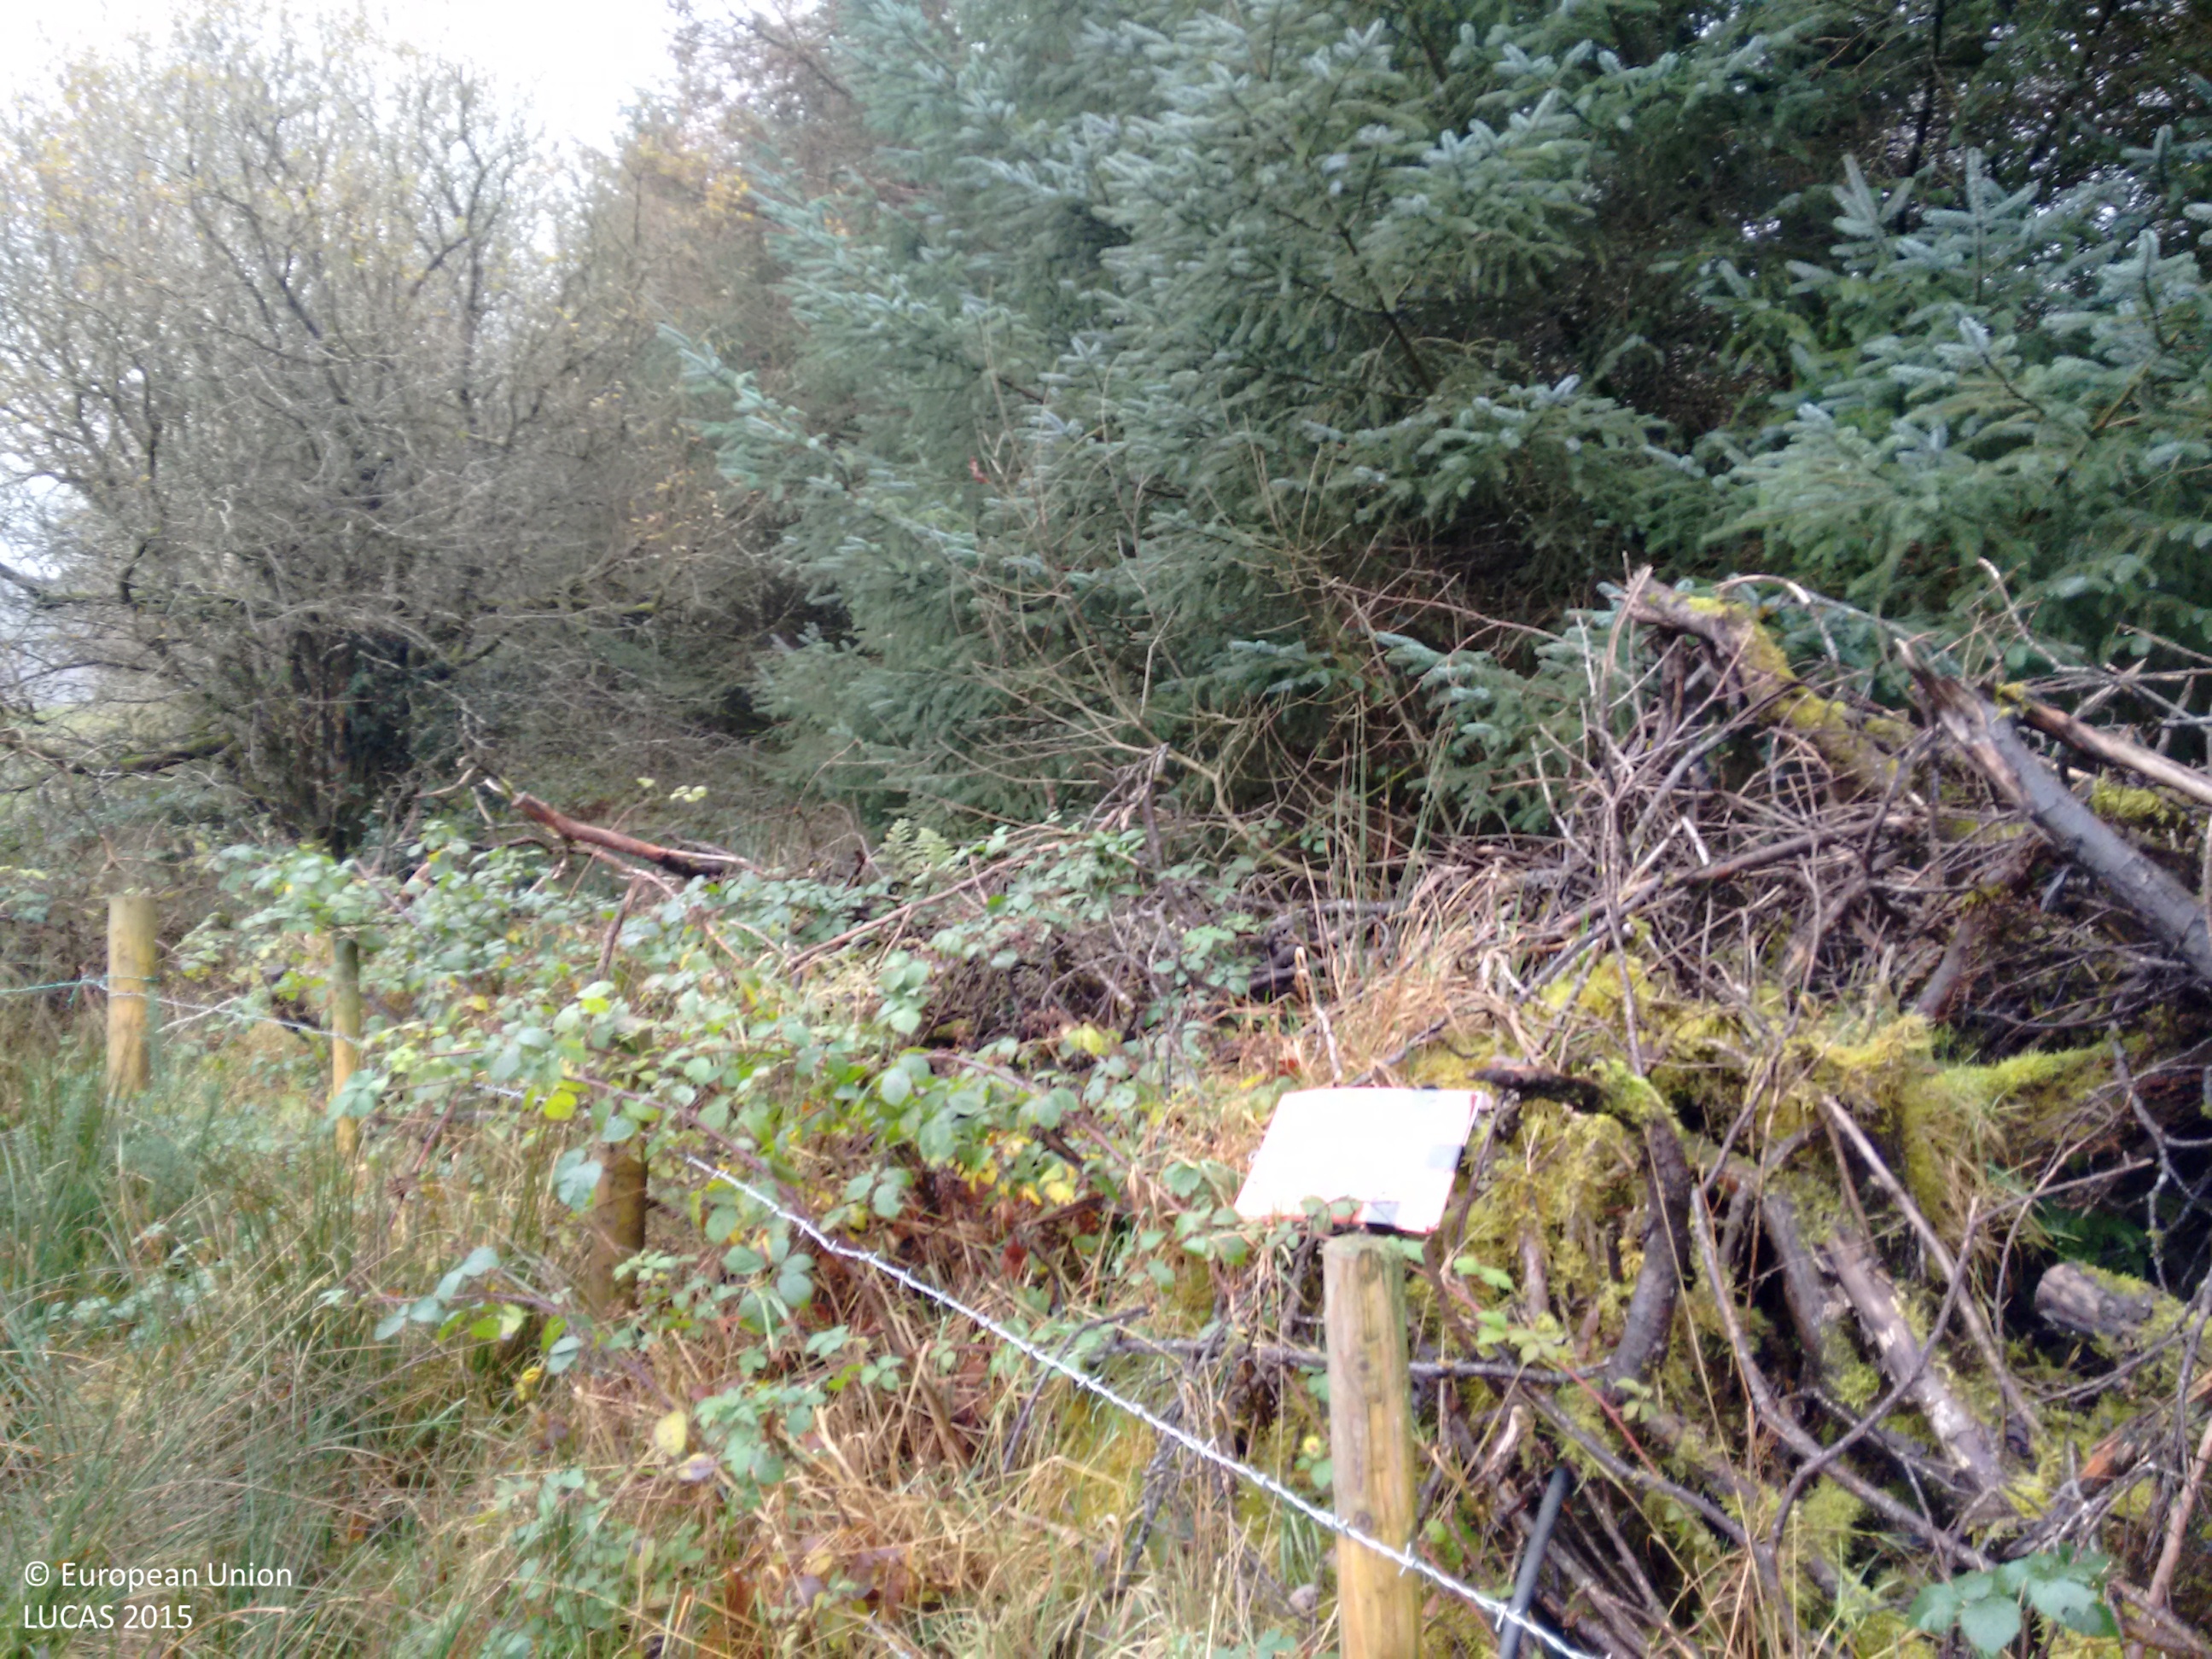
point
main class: Grassland
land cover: Grassland without tree/shrub cover
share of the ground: > 75 %
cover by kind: herbaceous plants 100 %
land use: Agriculture (excluding fallow land and kitchen gardens)
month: December
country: IE
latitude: 54.2911
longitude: -8.1060
